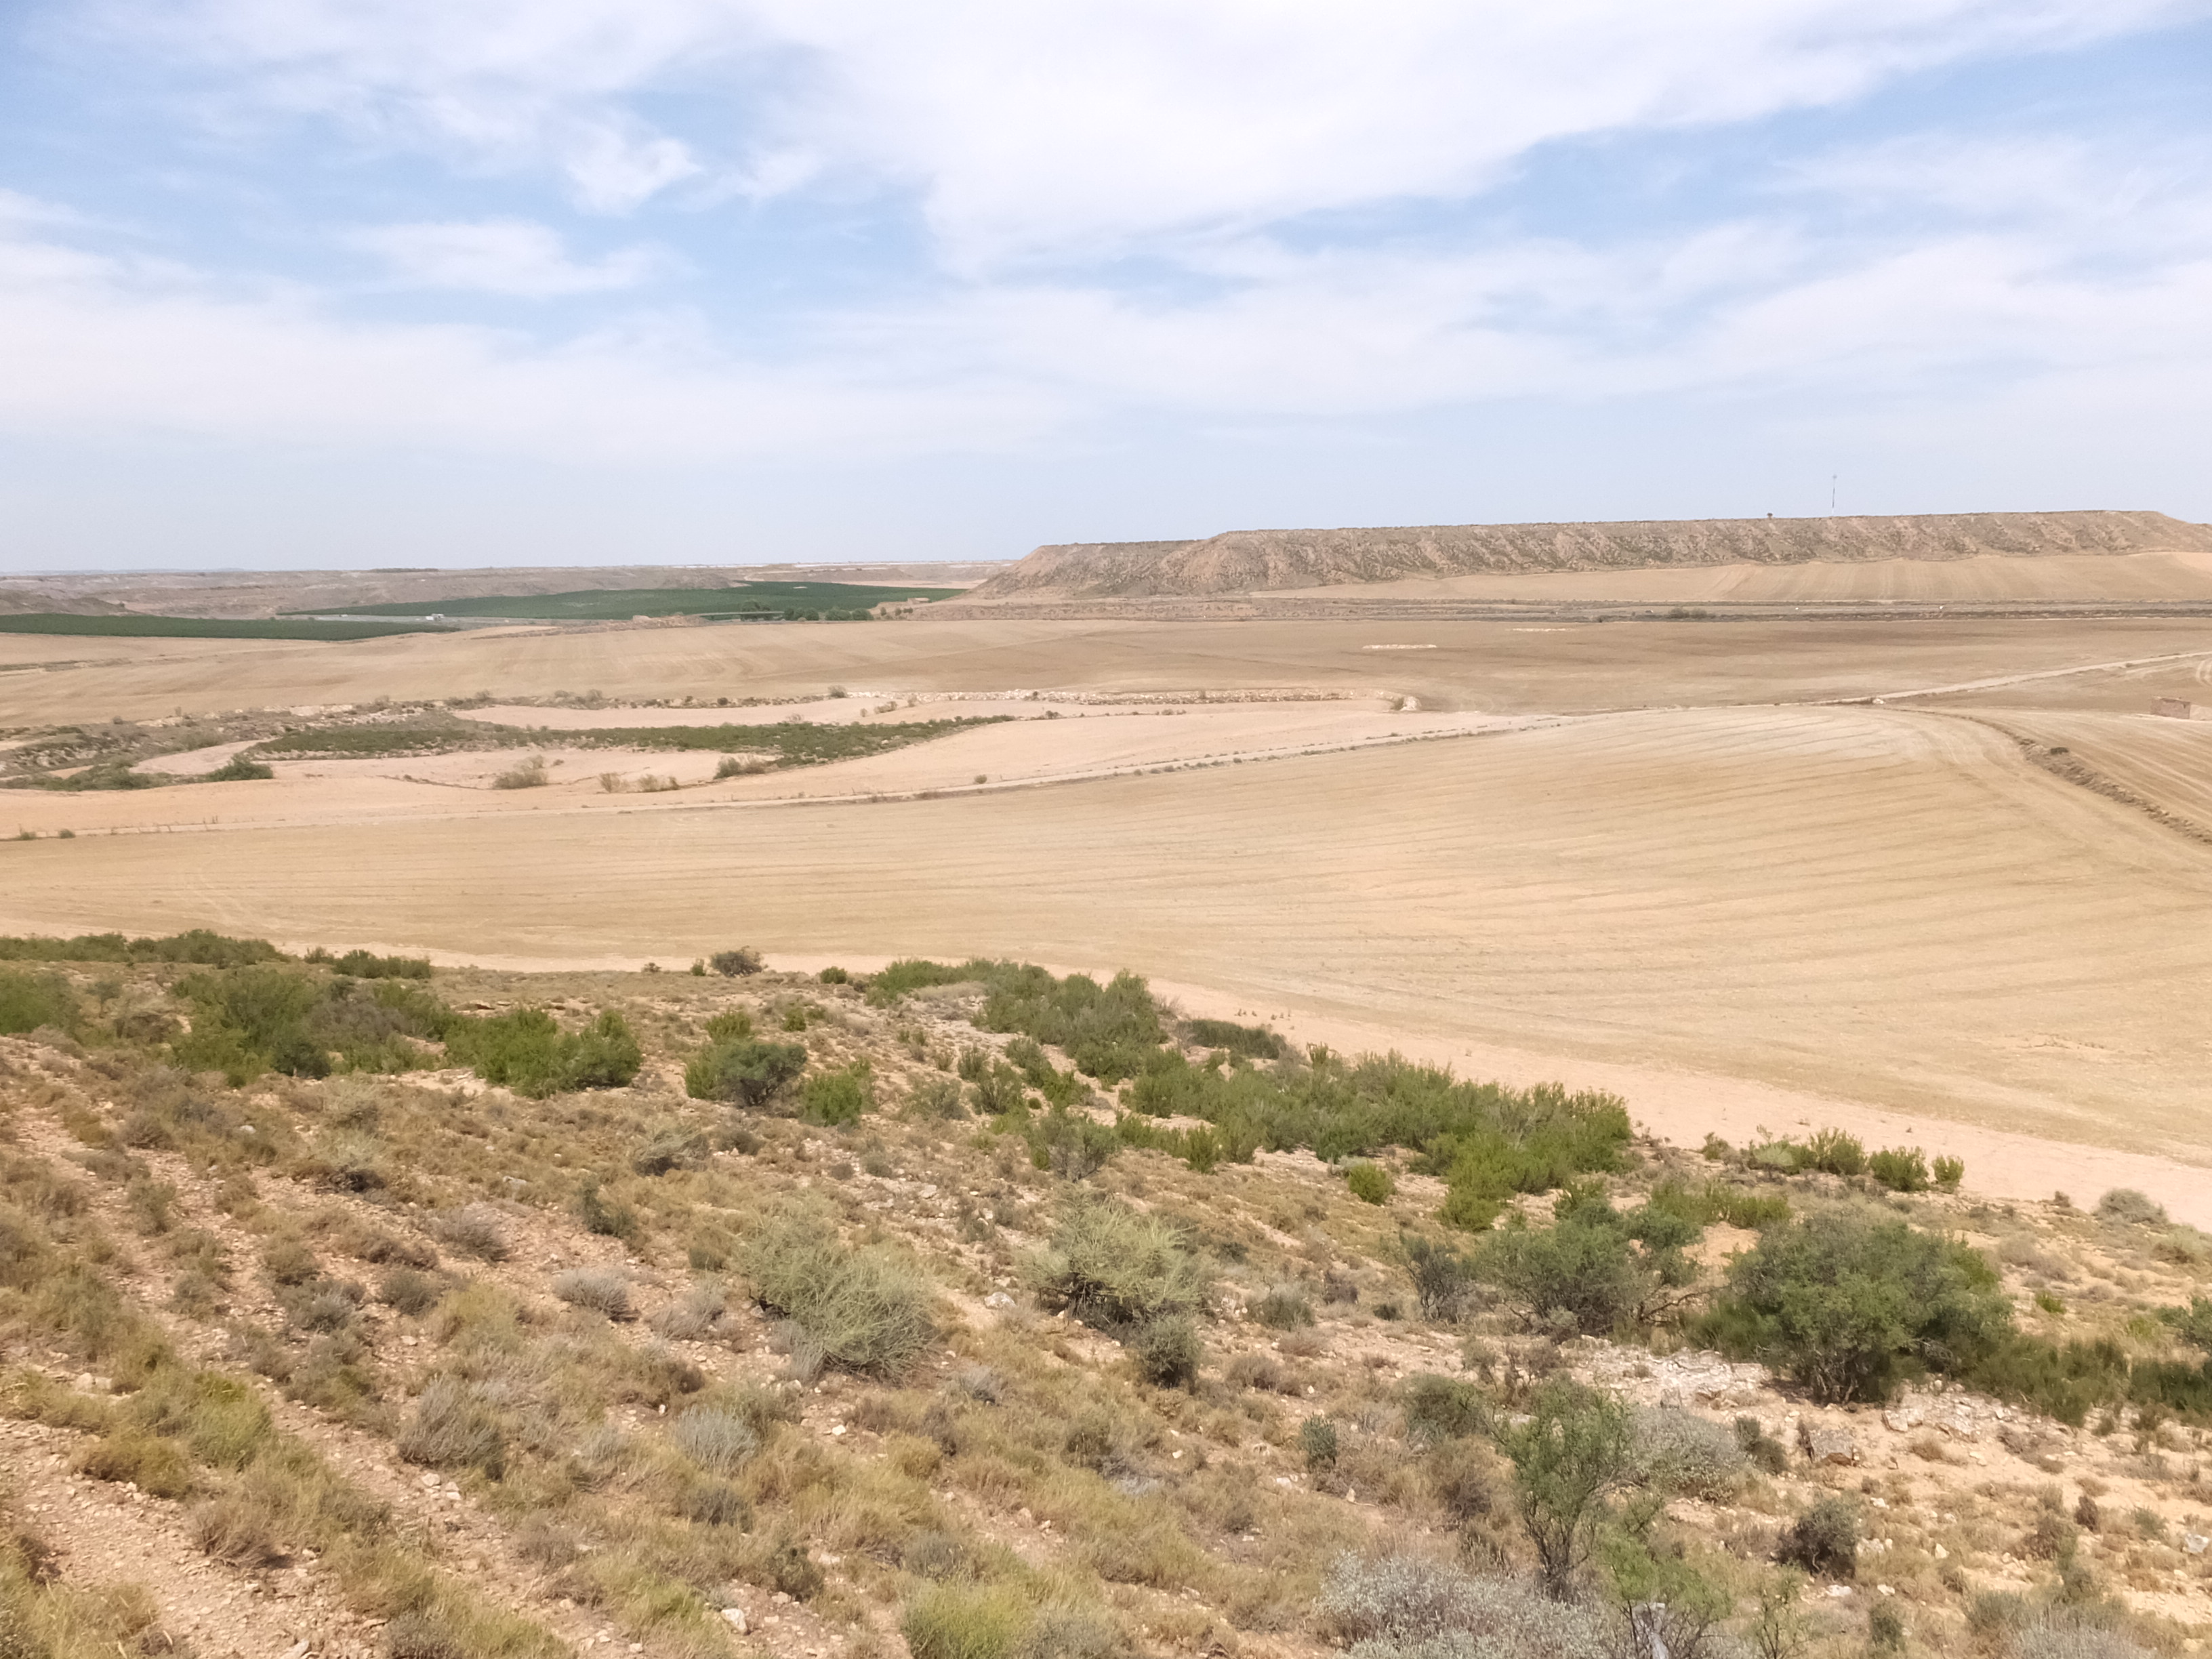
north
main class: Shrubland
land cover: Shrubland without tree cover
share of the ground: > 75 %
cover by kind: shrubs 70 %, herbaceous plants 20 %, consolidated bare surface 10 %
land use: Semi-natural and natural areas not in use
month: August
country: ES
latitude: 41.4821
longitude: 0.1540
